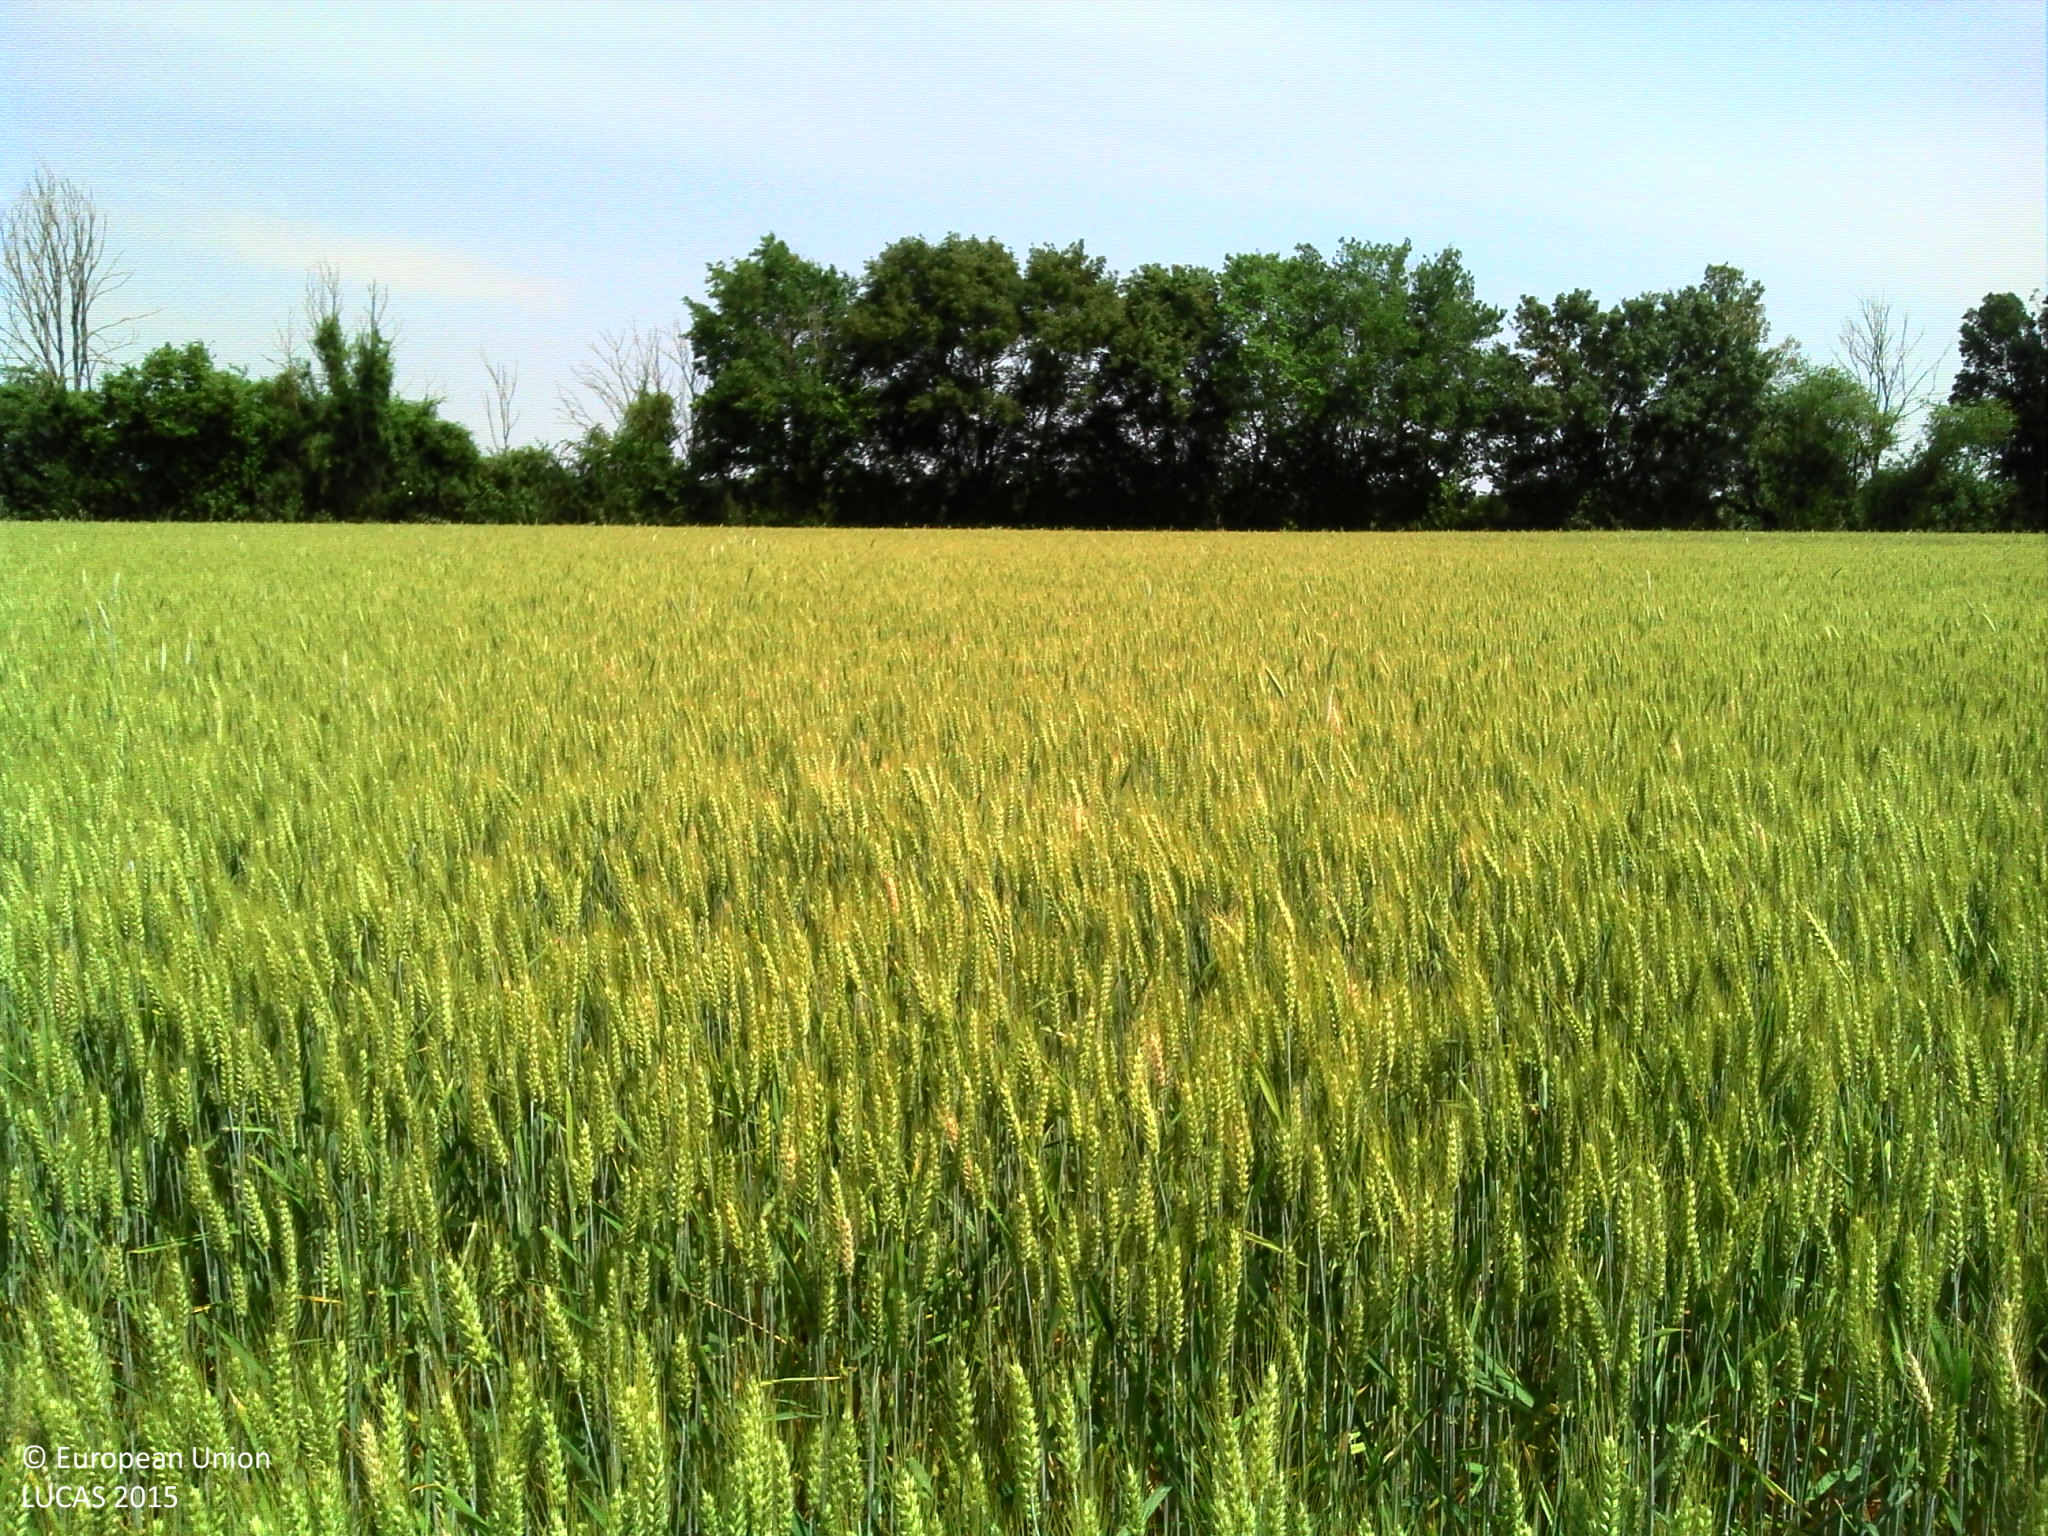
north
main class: Cropland
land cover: Common wheat
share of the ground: > 75 %
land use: Agriculture (excluding fallow land and kitchen gardens)
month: June
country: FR
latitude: 46.9658
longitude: 2.6474
